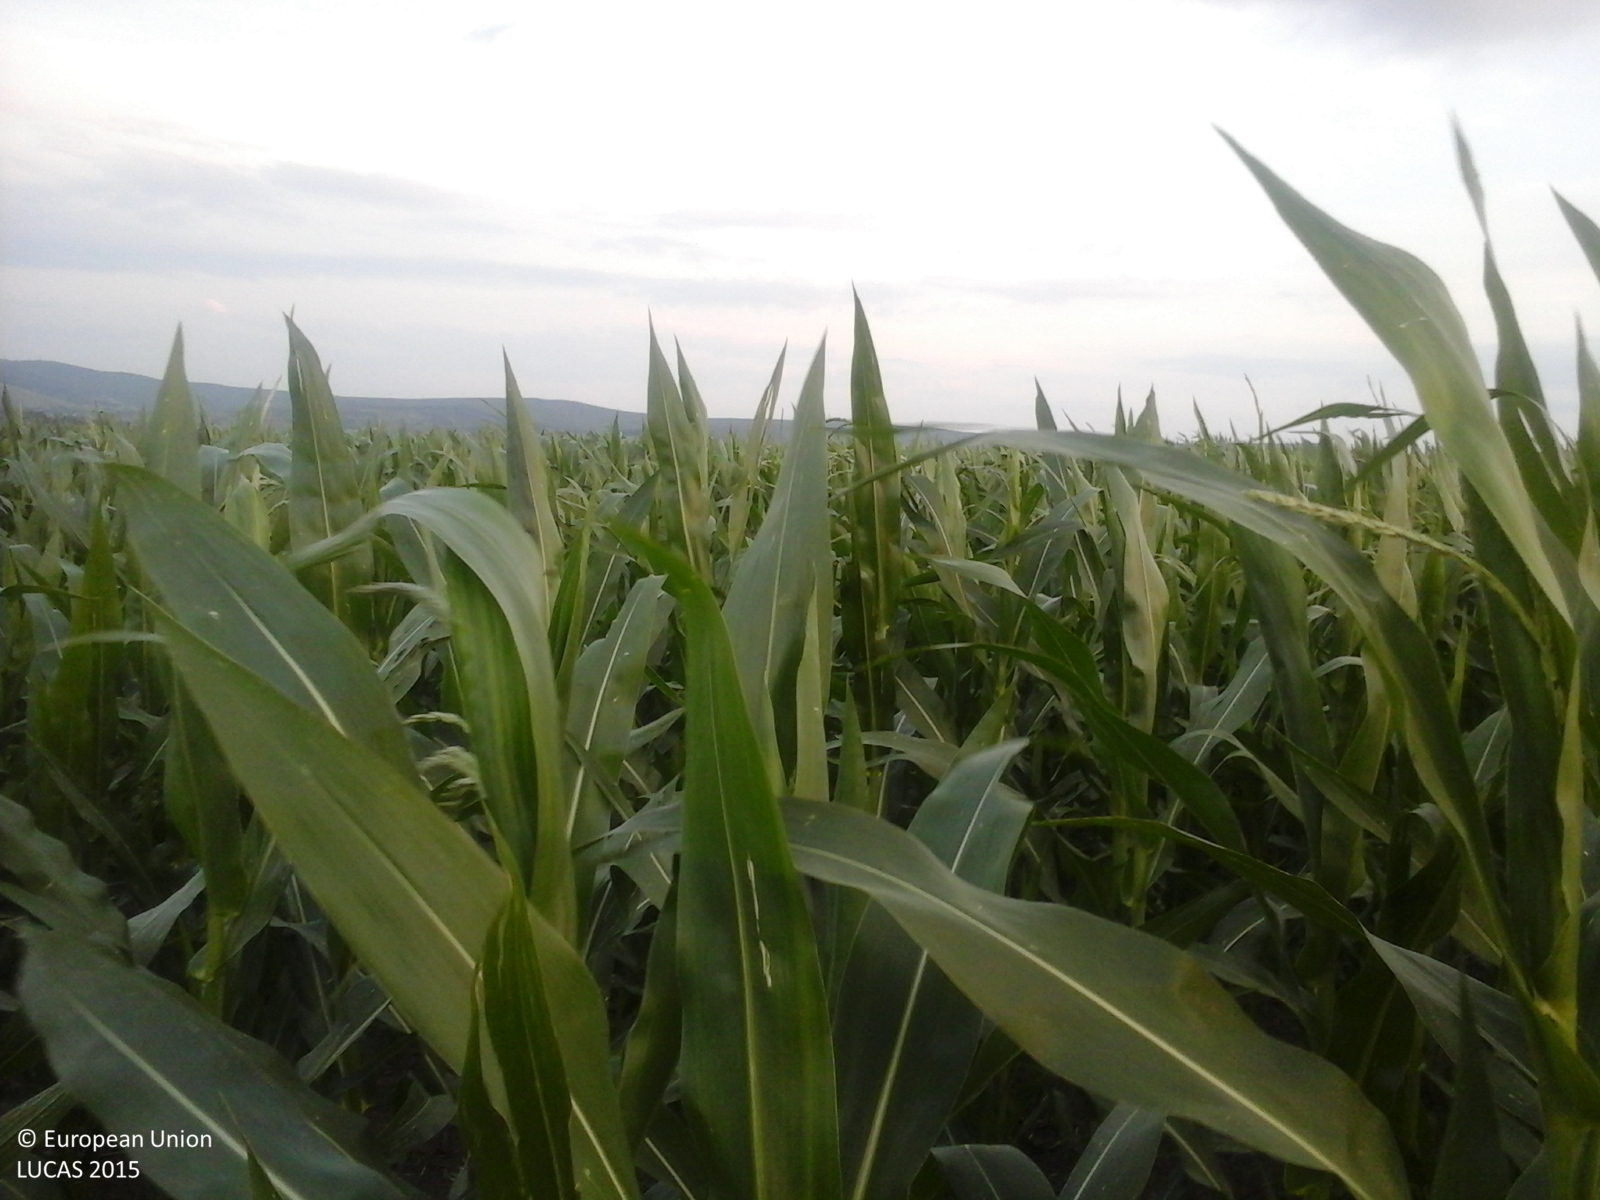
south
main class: Cropland
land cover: Maize
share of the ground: > 75 %
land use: Agriculture (excluding fallow land and kitchen gardens)
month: June
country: RO
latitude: 46.8560
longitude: 27.4378
